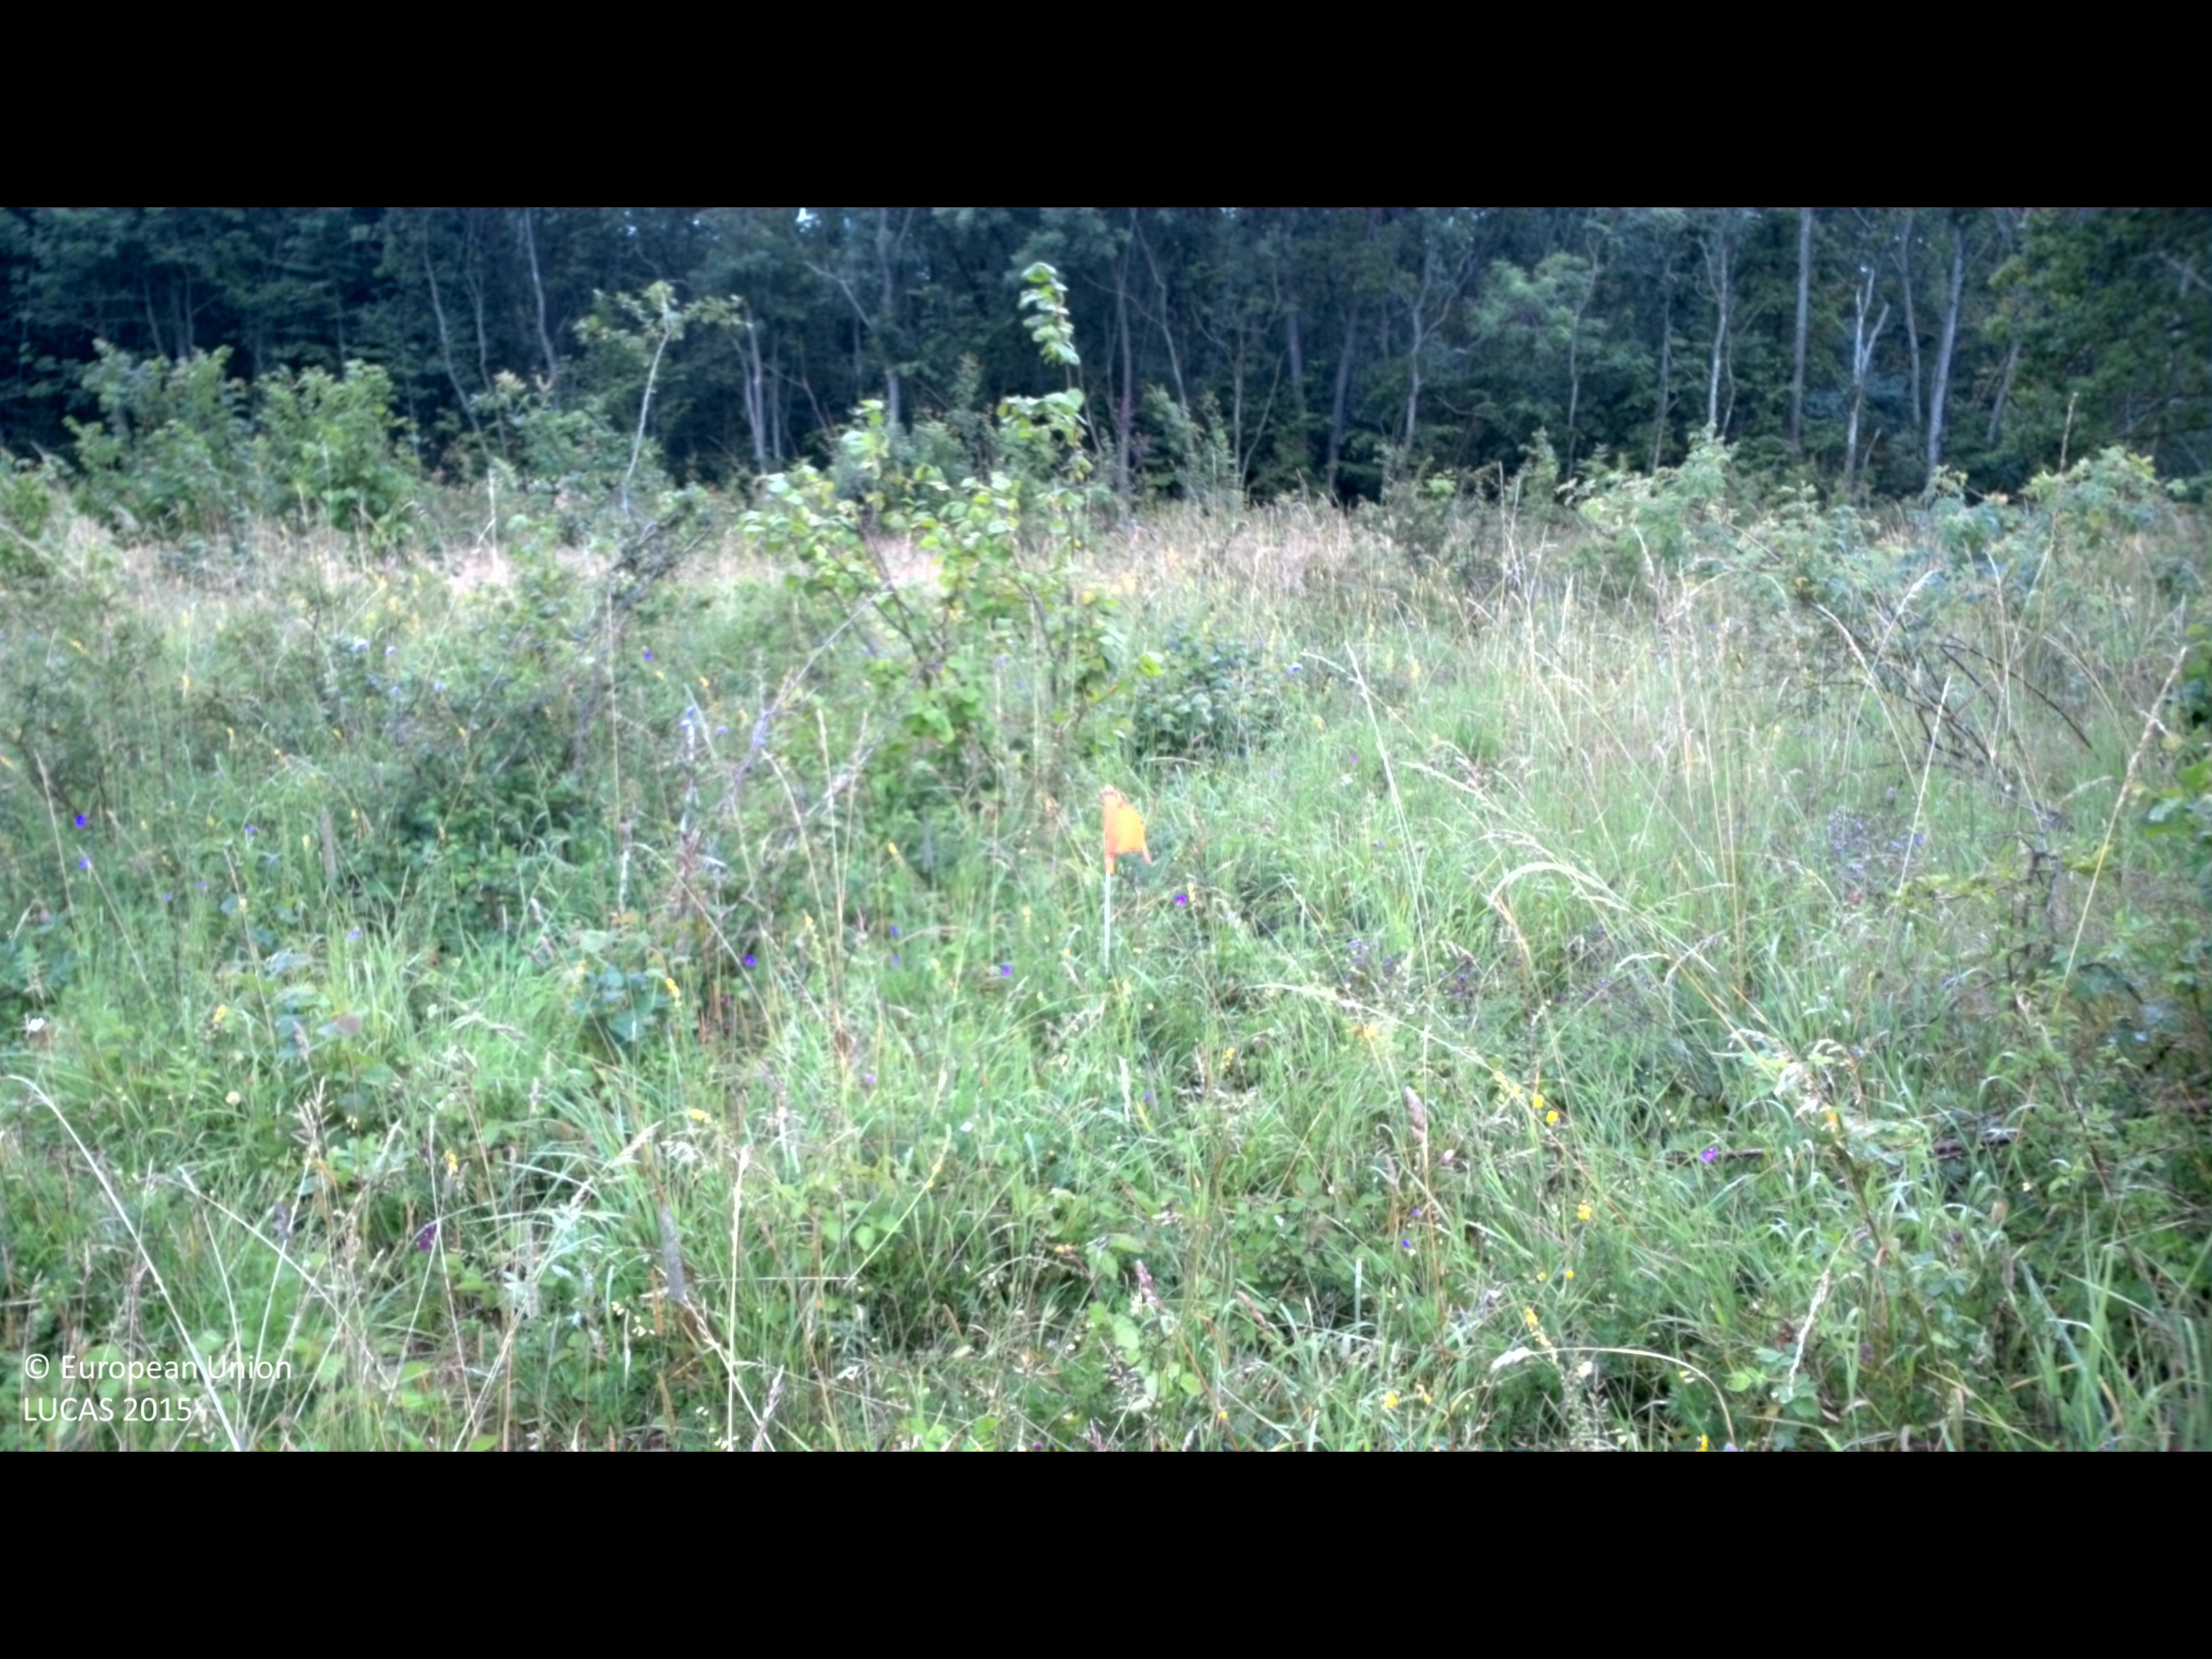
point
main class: Shrubland
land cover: Shrubland with sparse tree cover
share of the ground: > 75 %
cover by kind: shrubs 85 %, herbaceous plants 10 %, broadleaved forest trees 5 %
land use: Fallow land
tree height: > 5 m
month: July
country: SE
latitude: 56.7190
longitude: 16.6520
